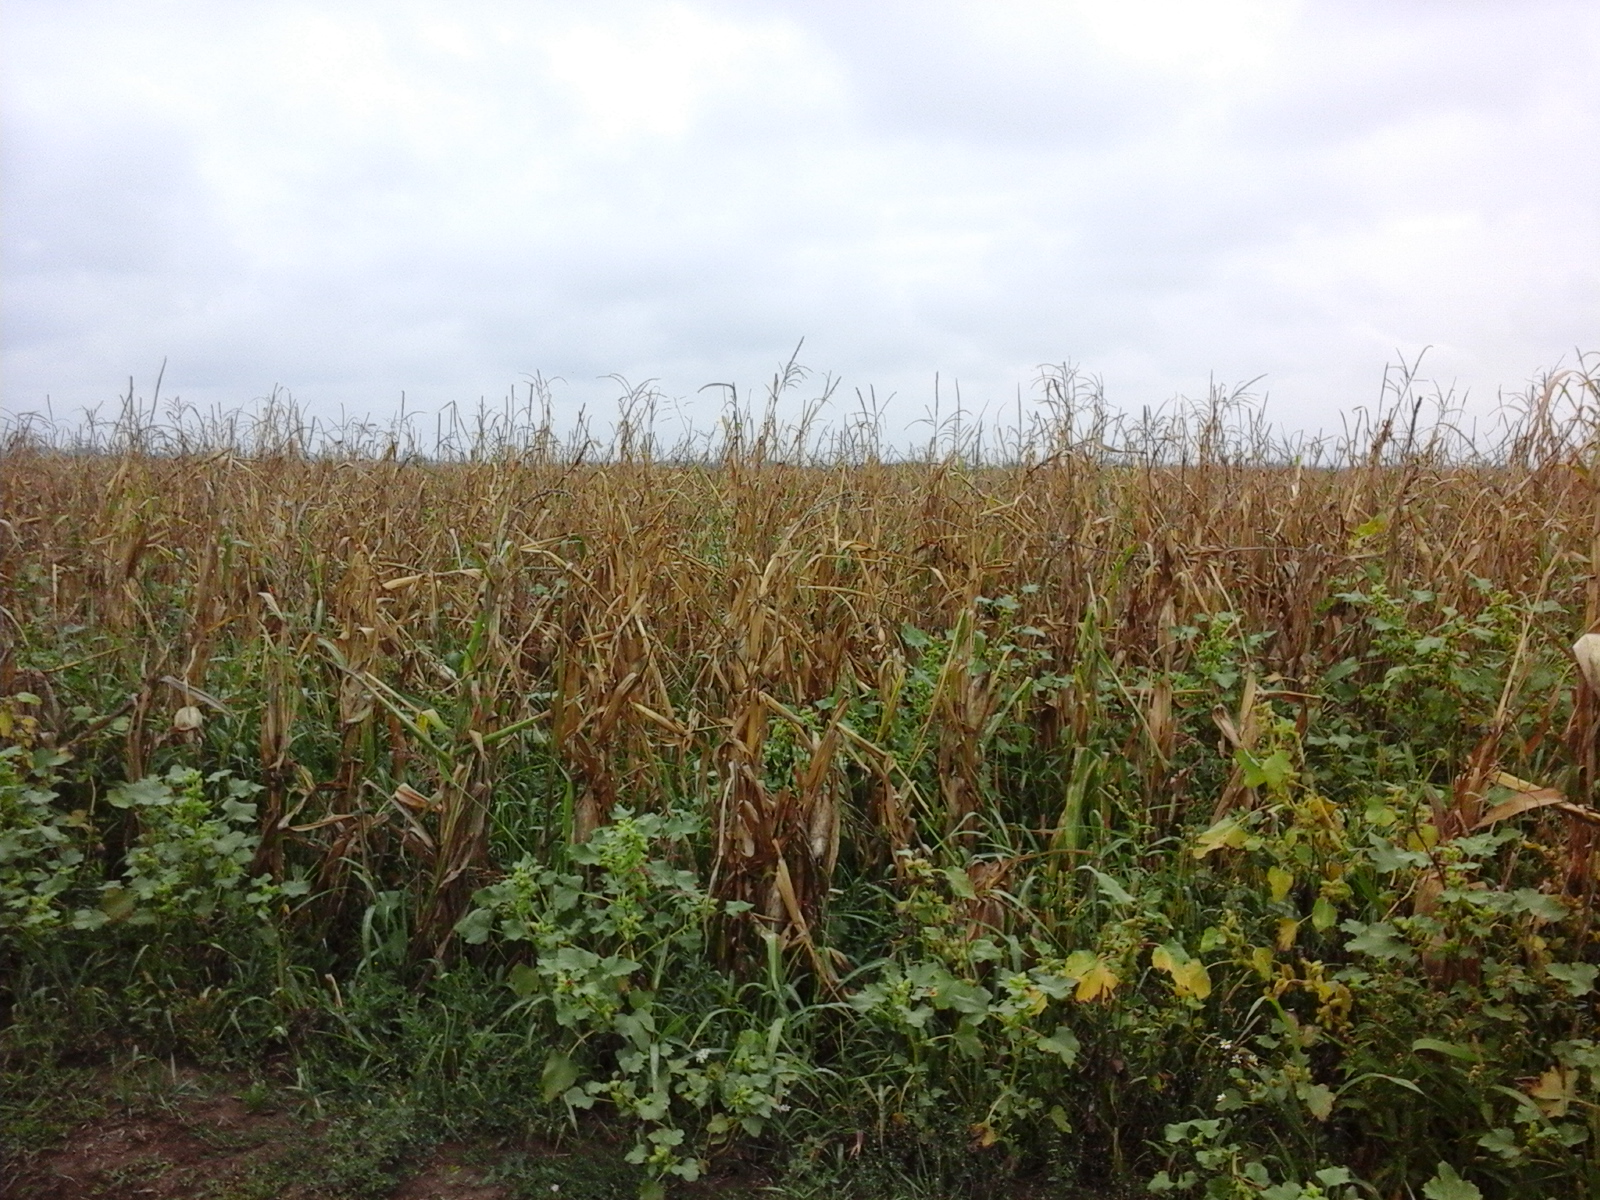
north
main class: Cropland
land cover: Maize
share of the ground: > 75 %
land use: Agriculture (excluding fallow land and kitchen gardens)
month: September
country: RO
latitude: 47.0952
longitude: 21.8097
